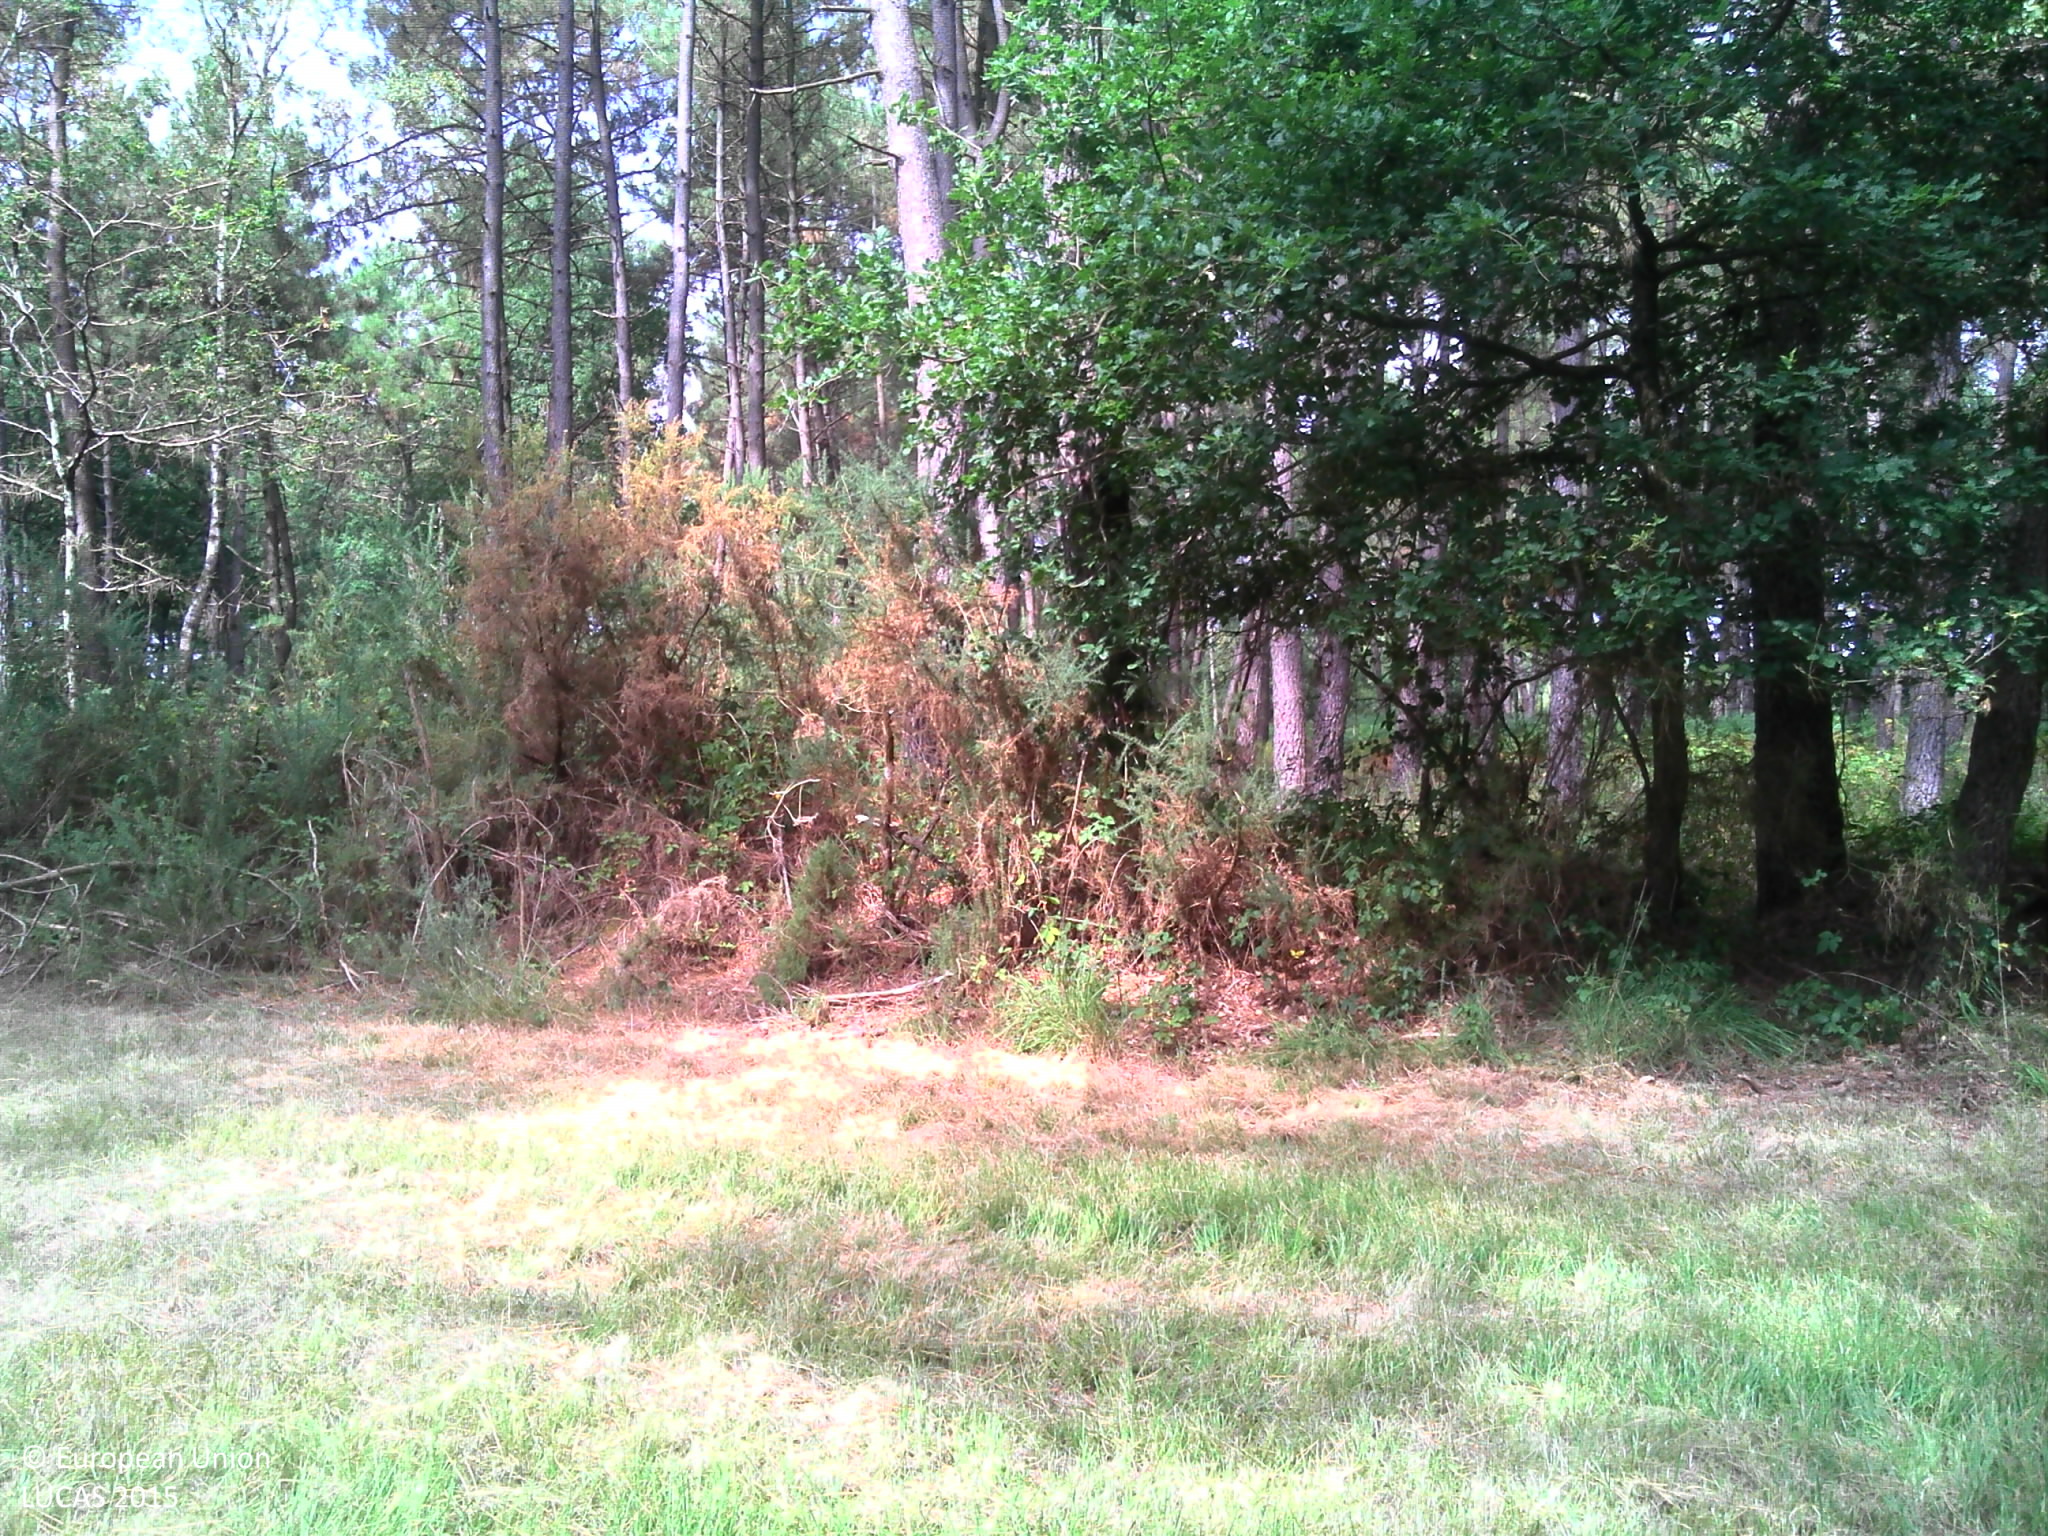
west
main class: Woodland
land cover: Pine dominated coniferous woodland
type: exotic forest
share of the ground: > 75 %
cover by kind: coniferous forest trees 55 %, herbaceous plants 20 %, broadleaved forest trees 10 %, shrubs 10 %, lichens and mosses 5 %
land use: Forestry
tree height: > 5 m
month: August
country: FR
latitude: 47.1815
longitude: 0.3322
